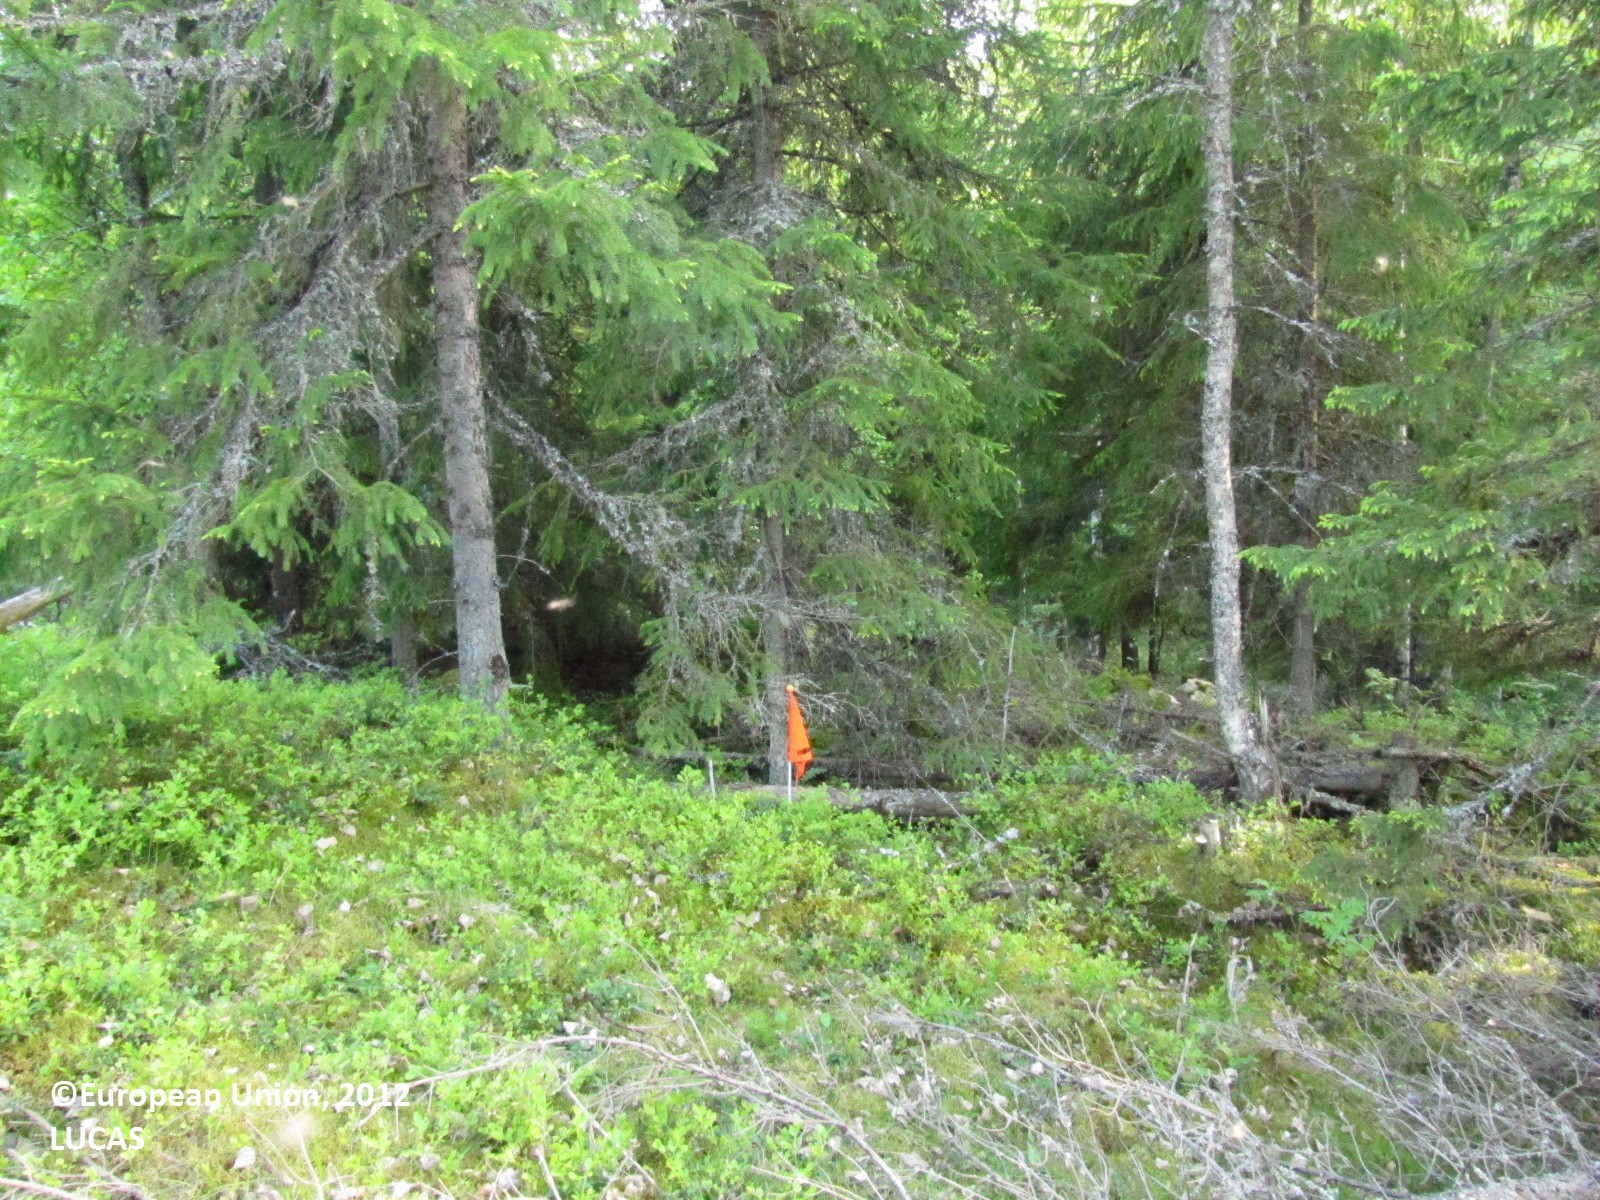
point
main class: Woodland
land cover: Spruce dominated coniferous woodland
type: boreal forest
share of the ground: > 75 %
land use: Forestry
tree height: < 5 m
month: June
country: FI
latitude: 61.6143
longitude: 22.9096
